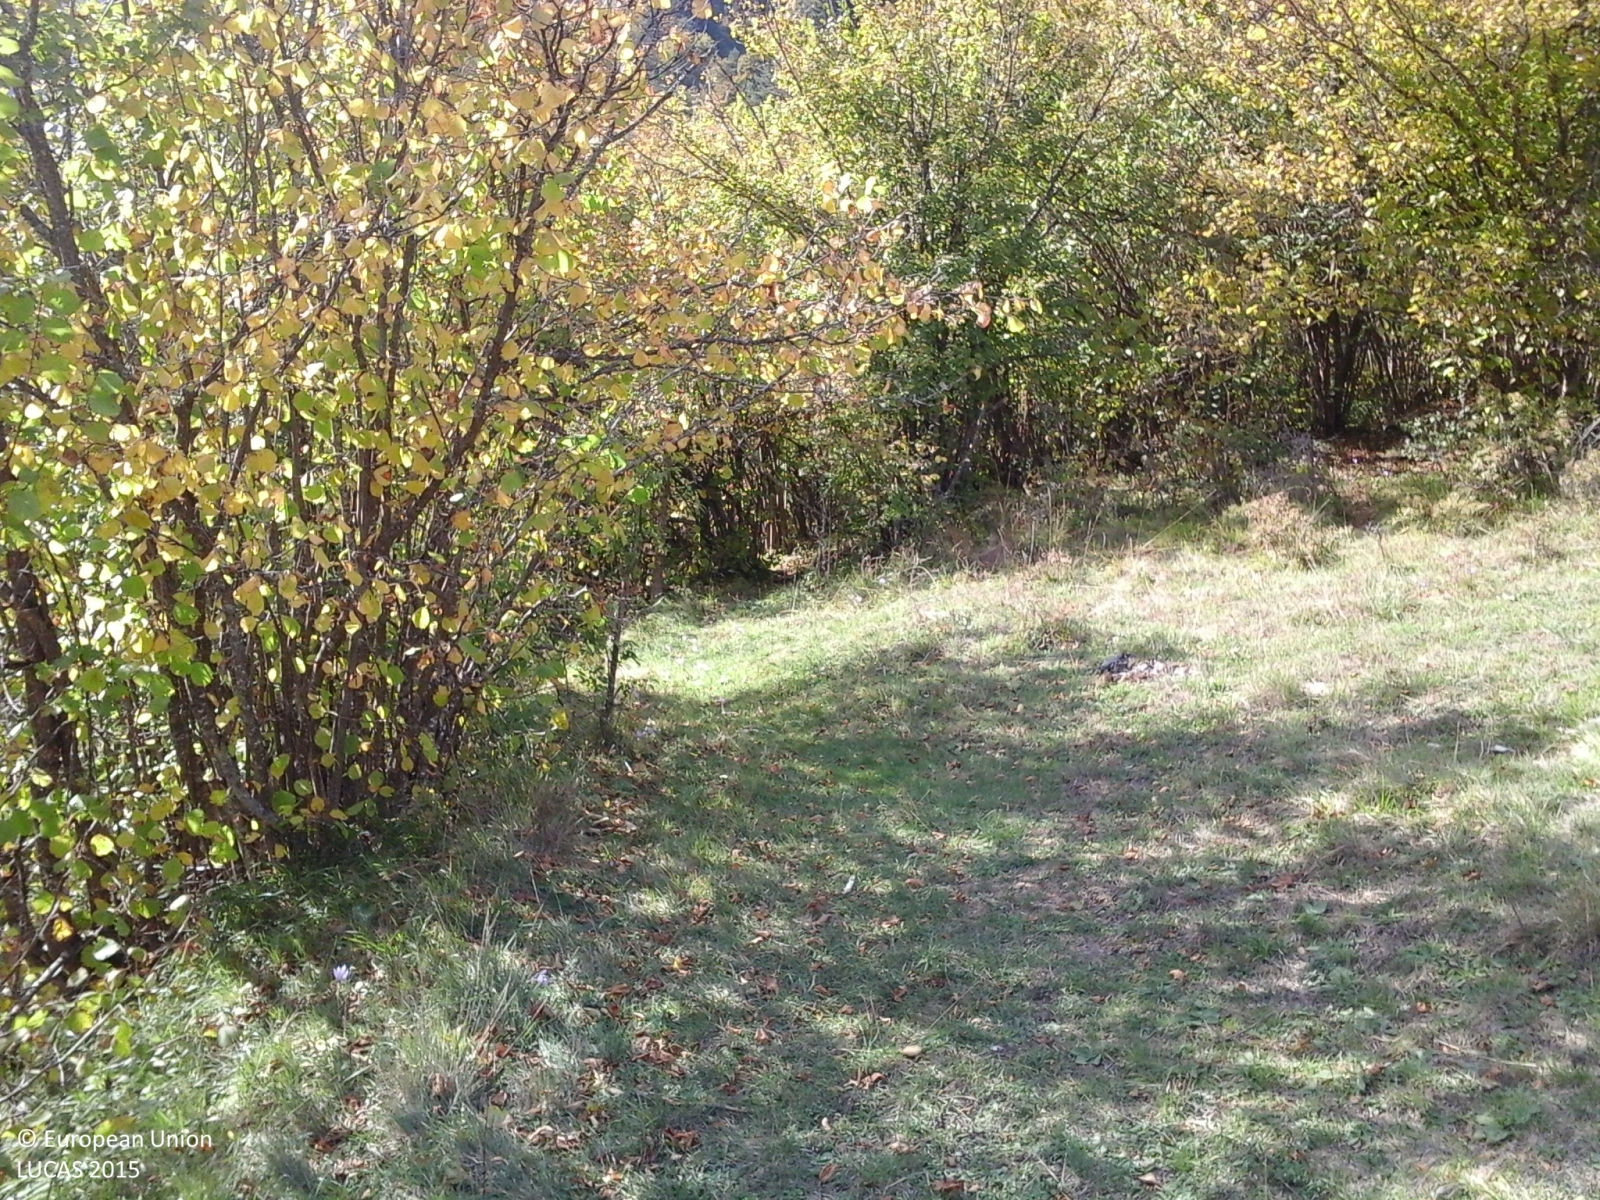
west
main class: Woodland
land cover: Broadleaved woodland
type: thermophilous deciduous forest
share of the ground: > 75 %
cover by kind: broadleaved forest trees 70 %, herbaceous plants 20 %, consolidated bare surface 10 %
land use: Semi-natural and natural areas not in use
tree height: < 5 m
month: October
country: IT
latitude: 44.1106
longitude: 7.7936
